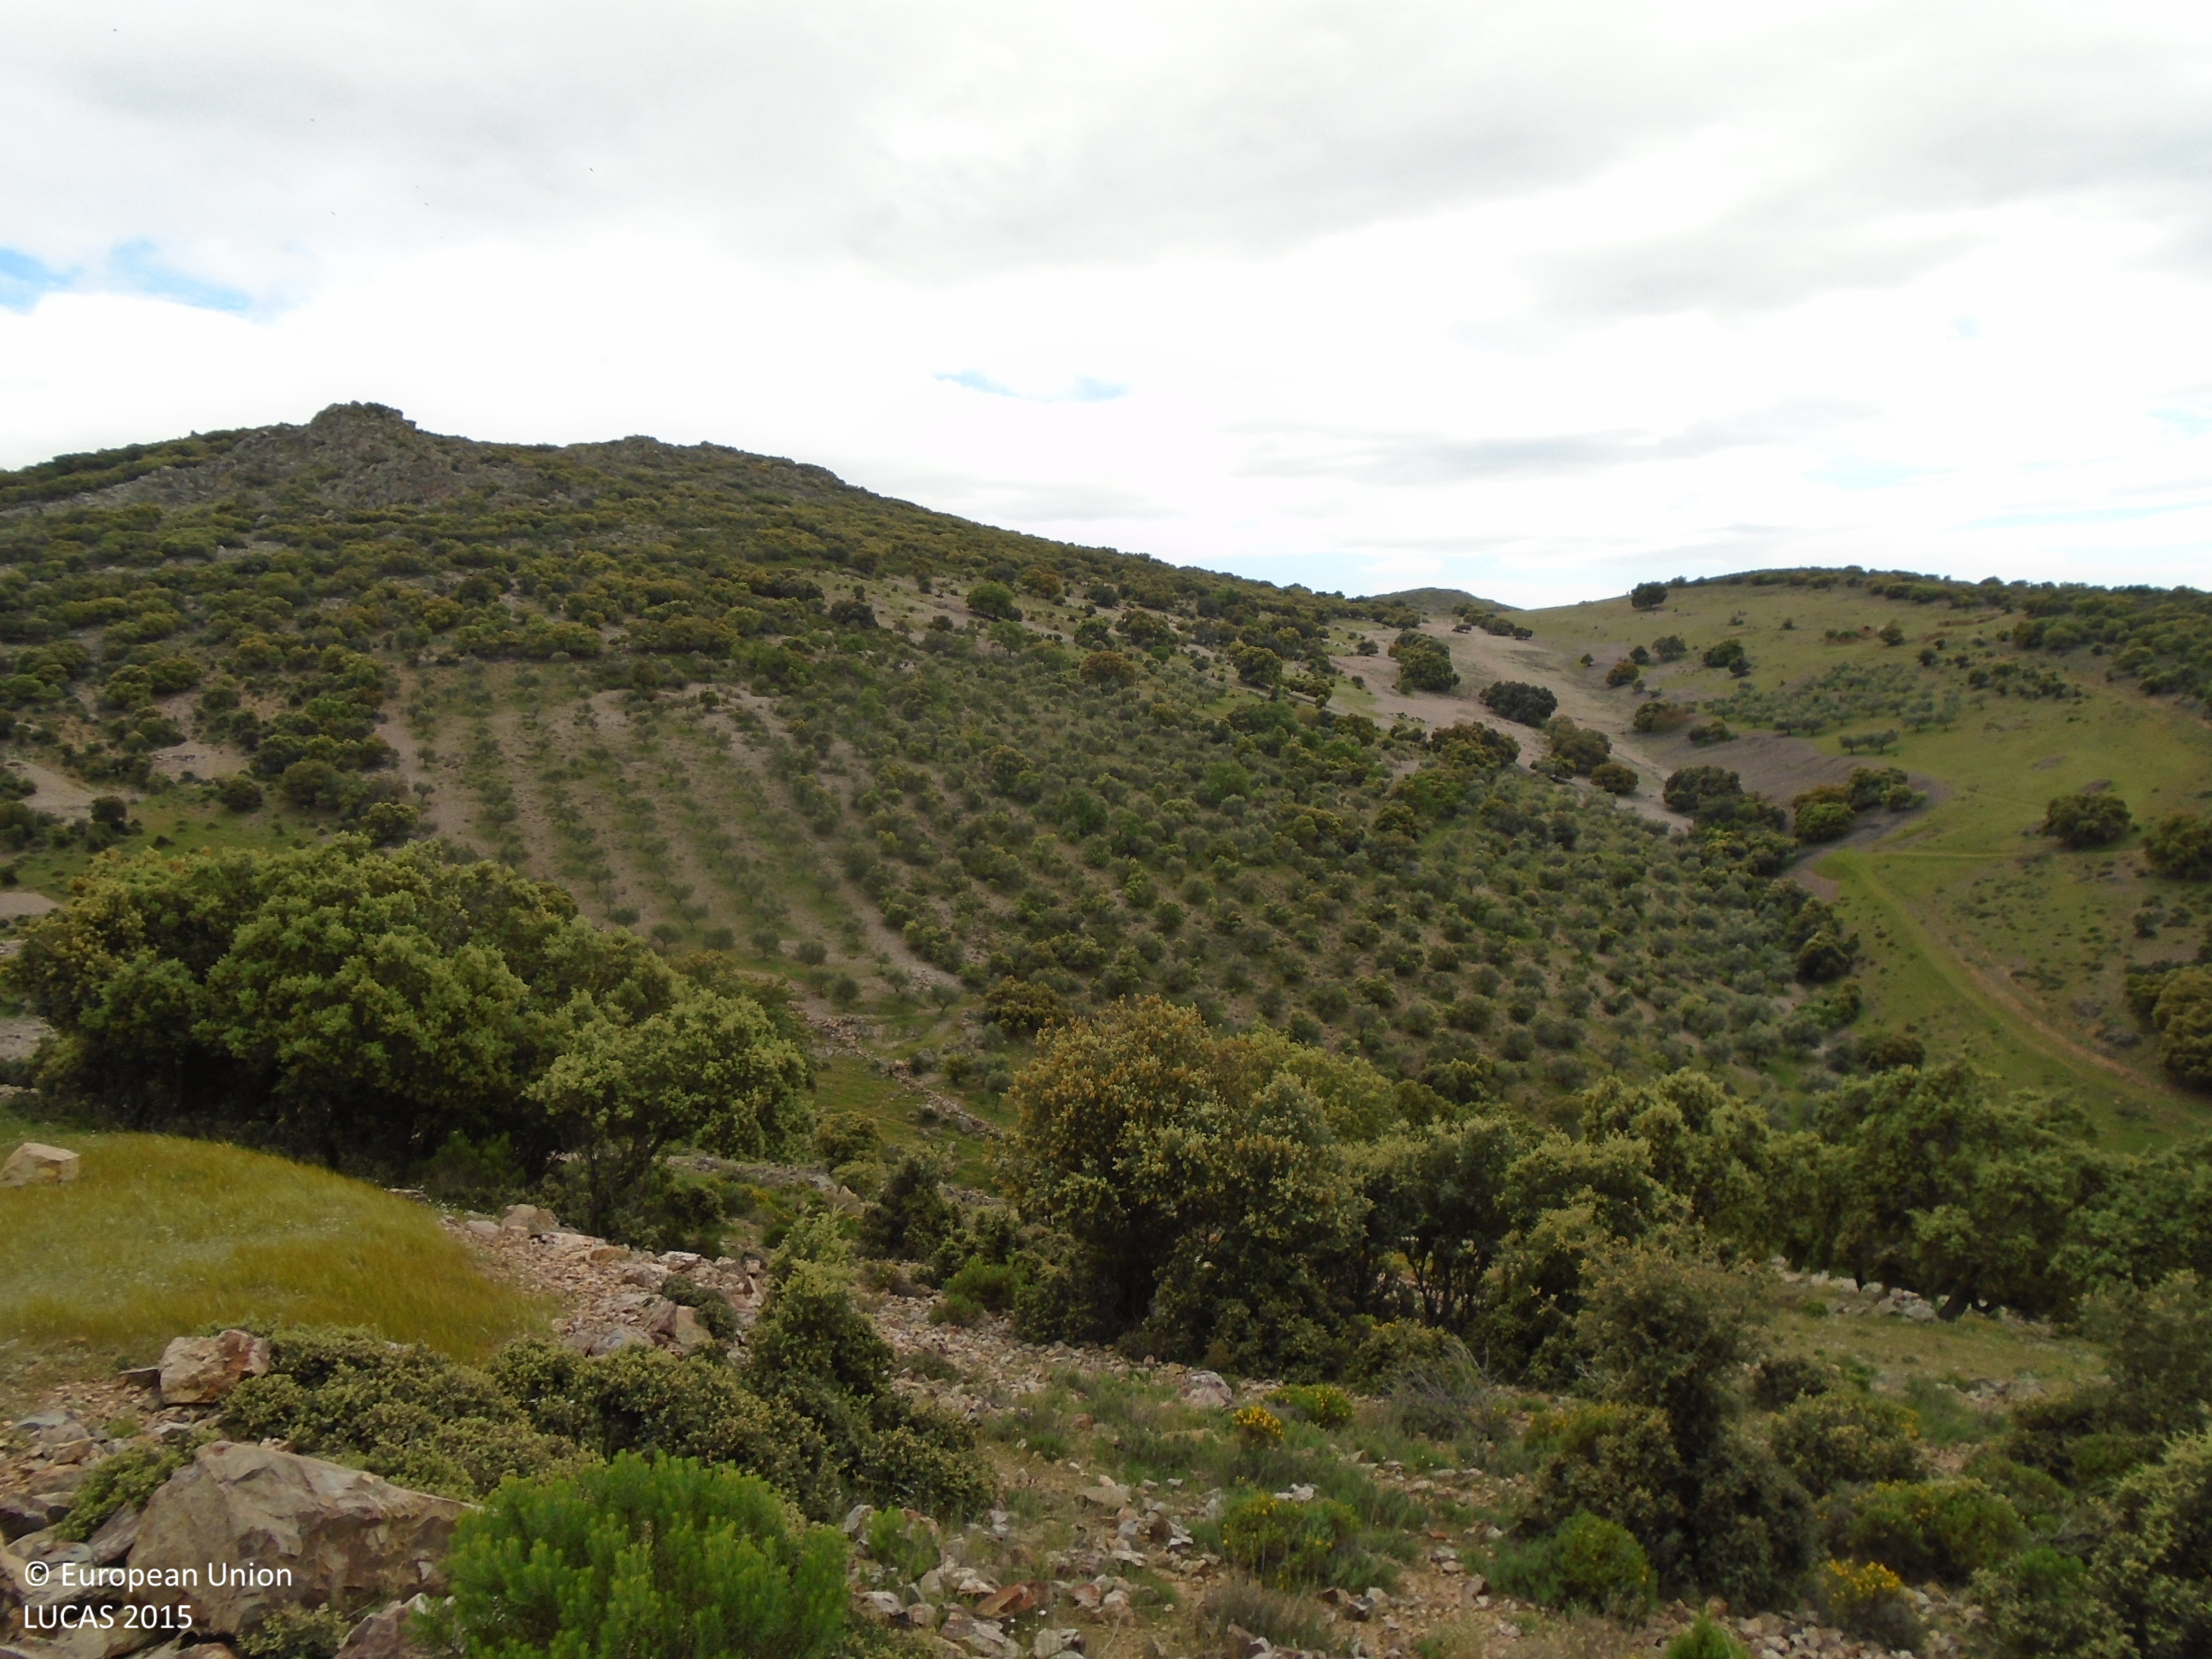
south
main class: Grassland
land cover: Grassland with sparse tree/shrub cover
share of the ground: > 75 %
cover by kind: herbaceous plants 85 %, broadleaved forest trees 5 %, shrubs 5 %, consolidated bare surface 5 %
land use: Semi-natural and natural areas not in use
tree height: < 5 m
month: May
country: ES
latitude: 39.6609
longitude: -4.6215
